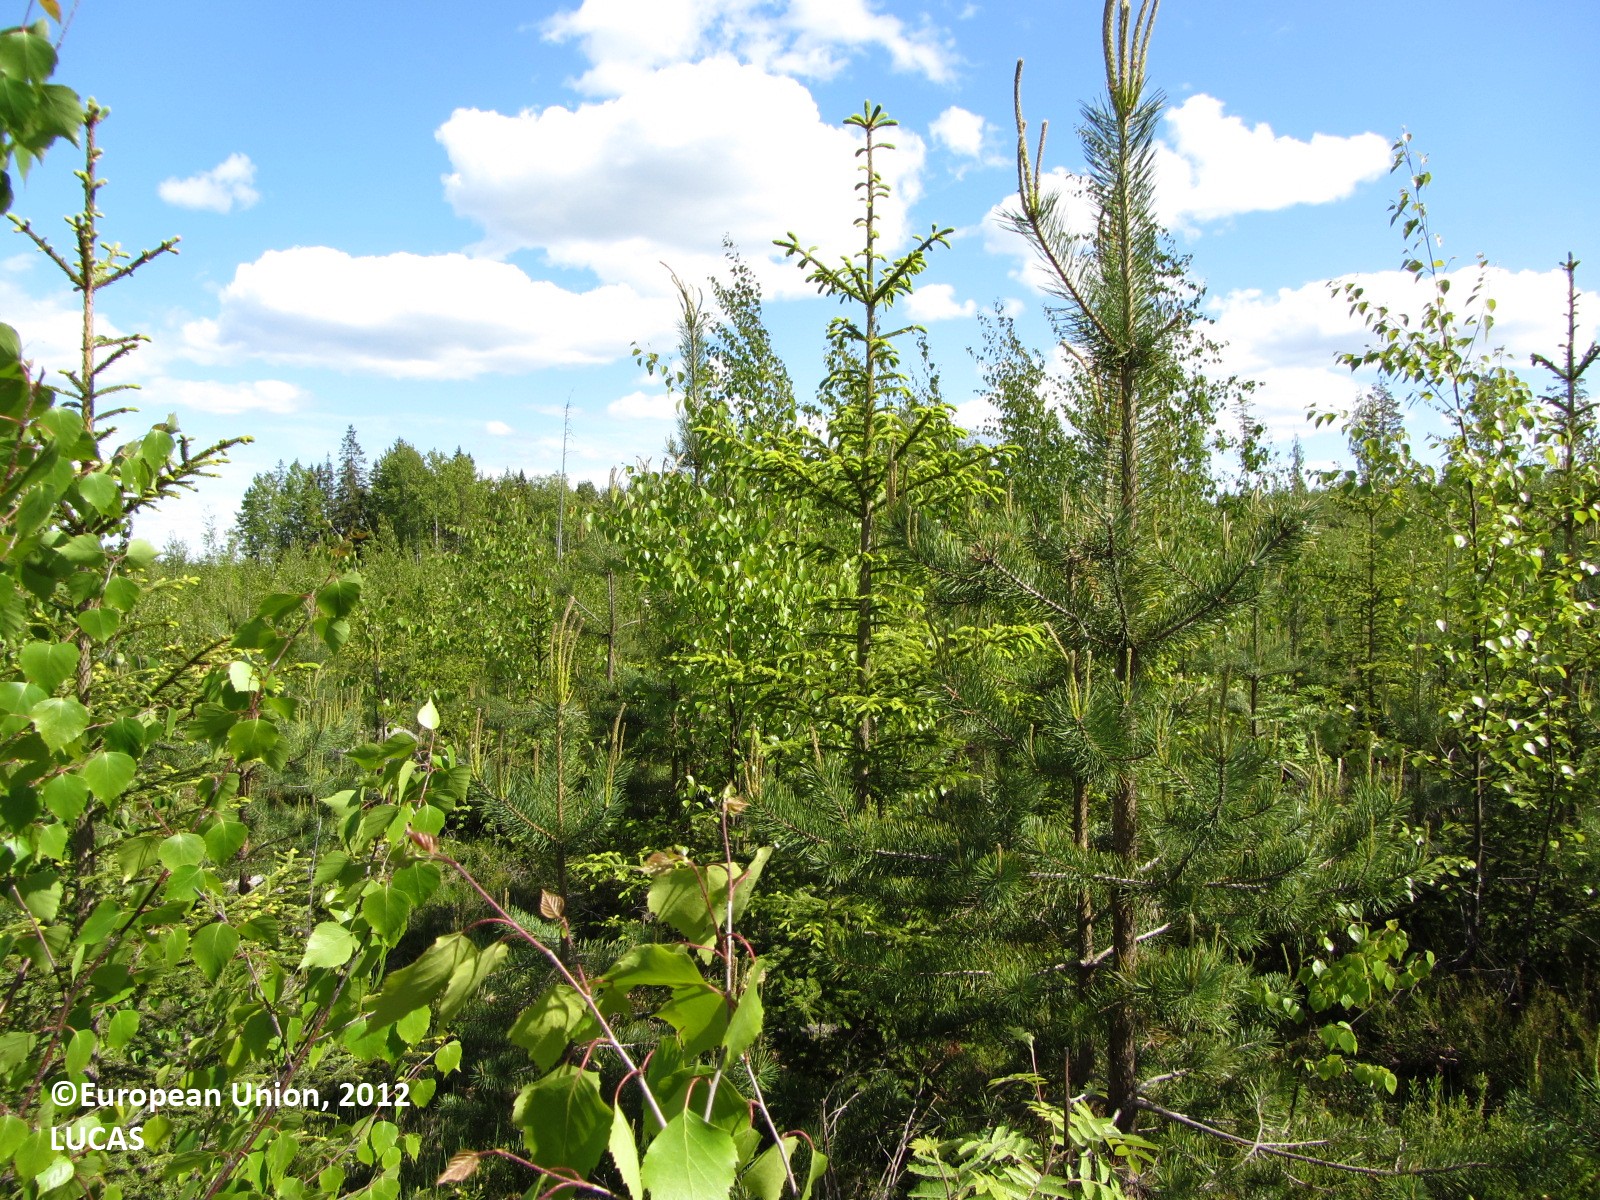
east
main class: Woodland
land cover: Other mixed woodland
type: hemiboreal forest and nemoral coniferous forest and mixed broadleaved-coniferous forest
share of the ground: > 75 %
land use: Forestry
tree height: < 5 m
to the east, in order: Other mixed woodland; Shrubland with sparse tree cover; Broadleaved woodland; Ditches and canals; Broadleaved woodland; Other mixed woodland
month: June
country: FI
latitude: 61.7318
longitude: 25.1197
